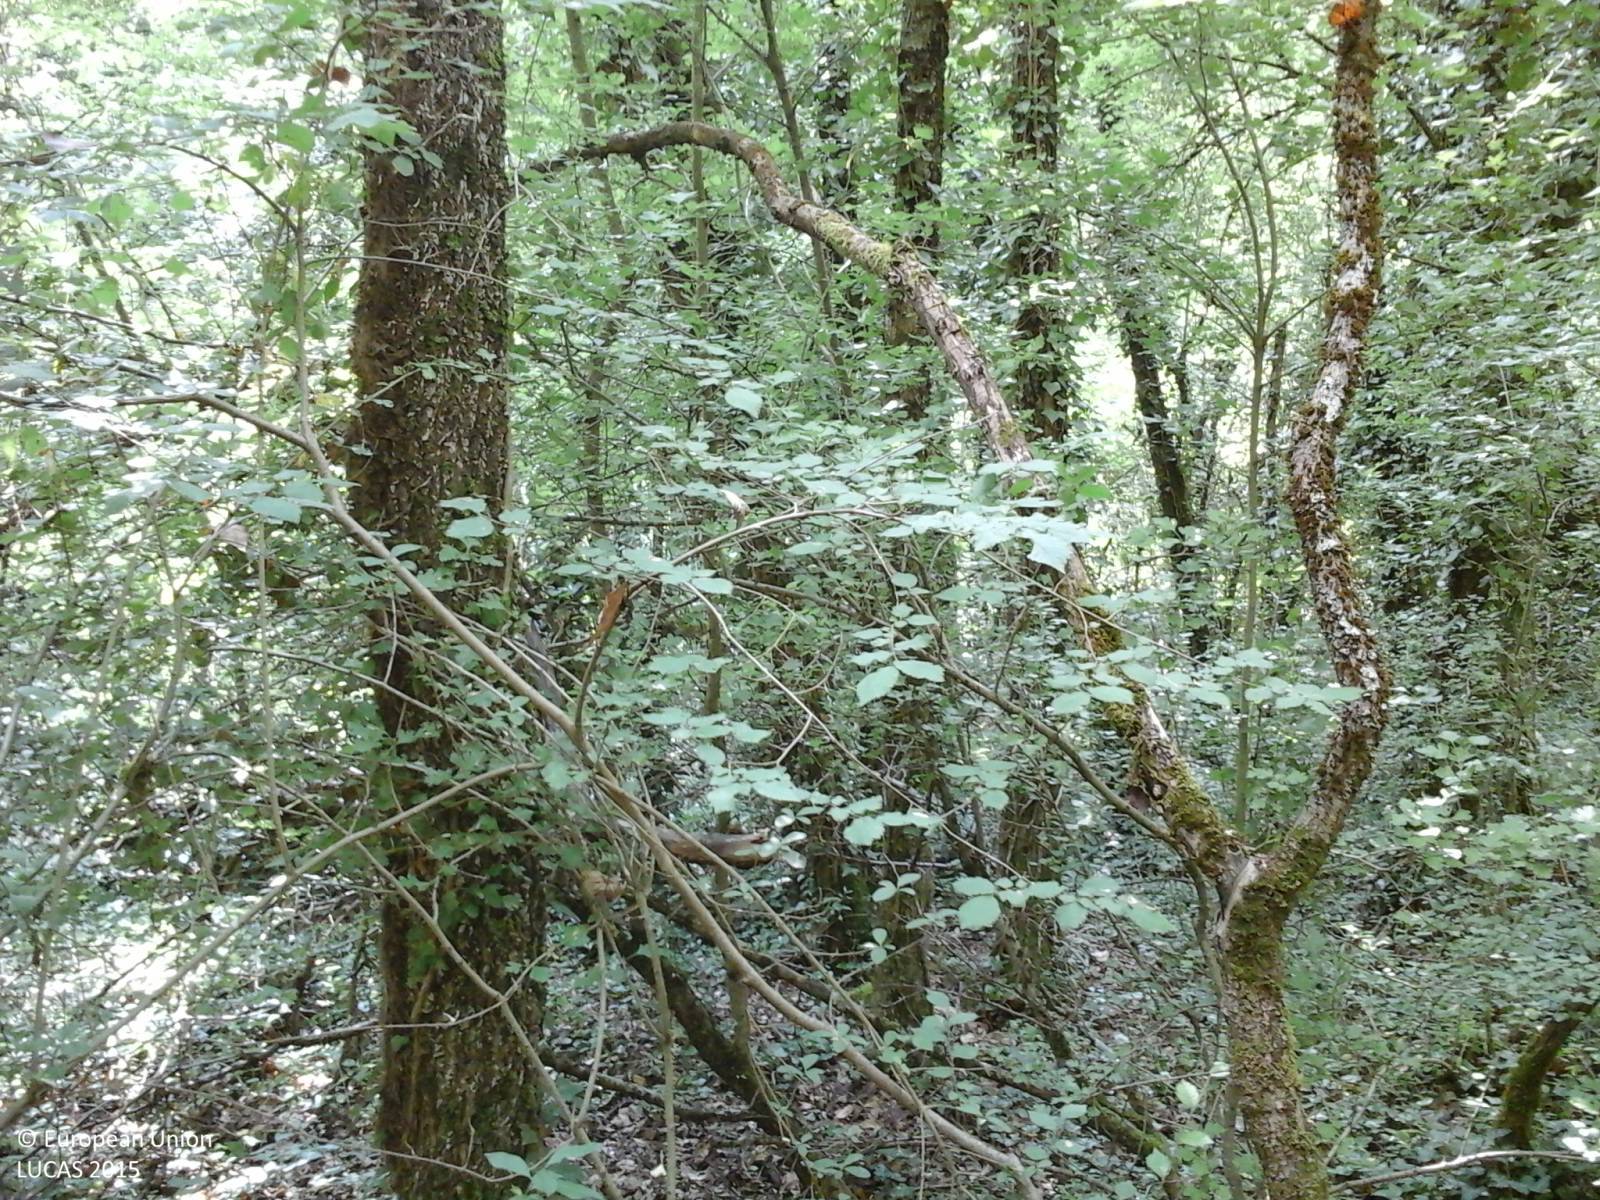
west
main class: Woodland
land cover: Broadleaved woodland
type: thermophilous deciduous forest
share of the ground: > 75 %
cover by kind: broadleaved forest trees 100 %
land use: Forestry
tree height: > 5 m
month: June
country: IT
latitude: 42.0371
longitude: 13.3827
